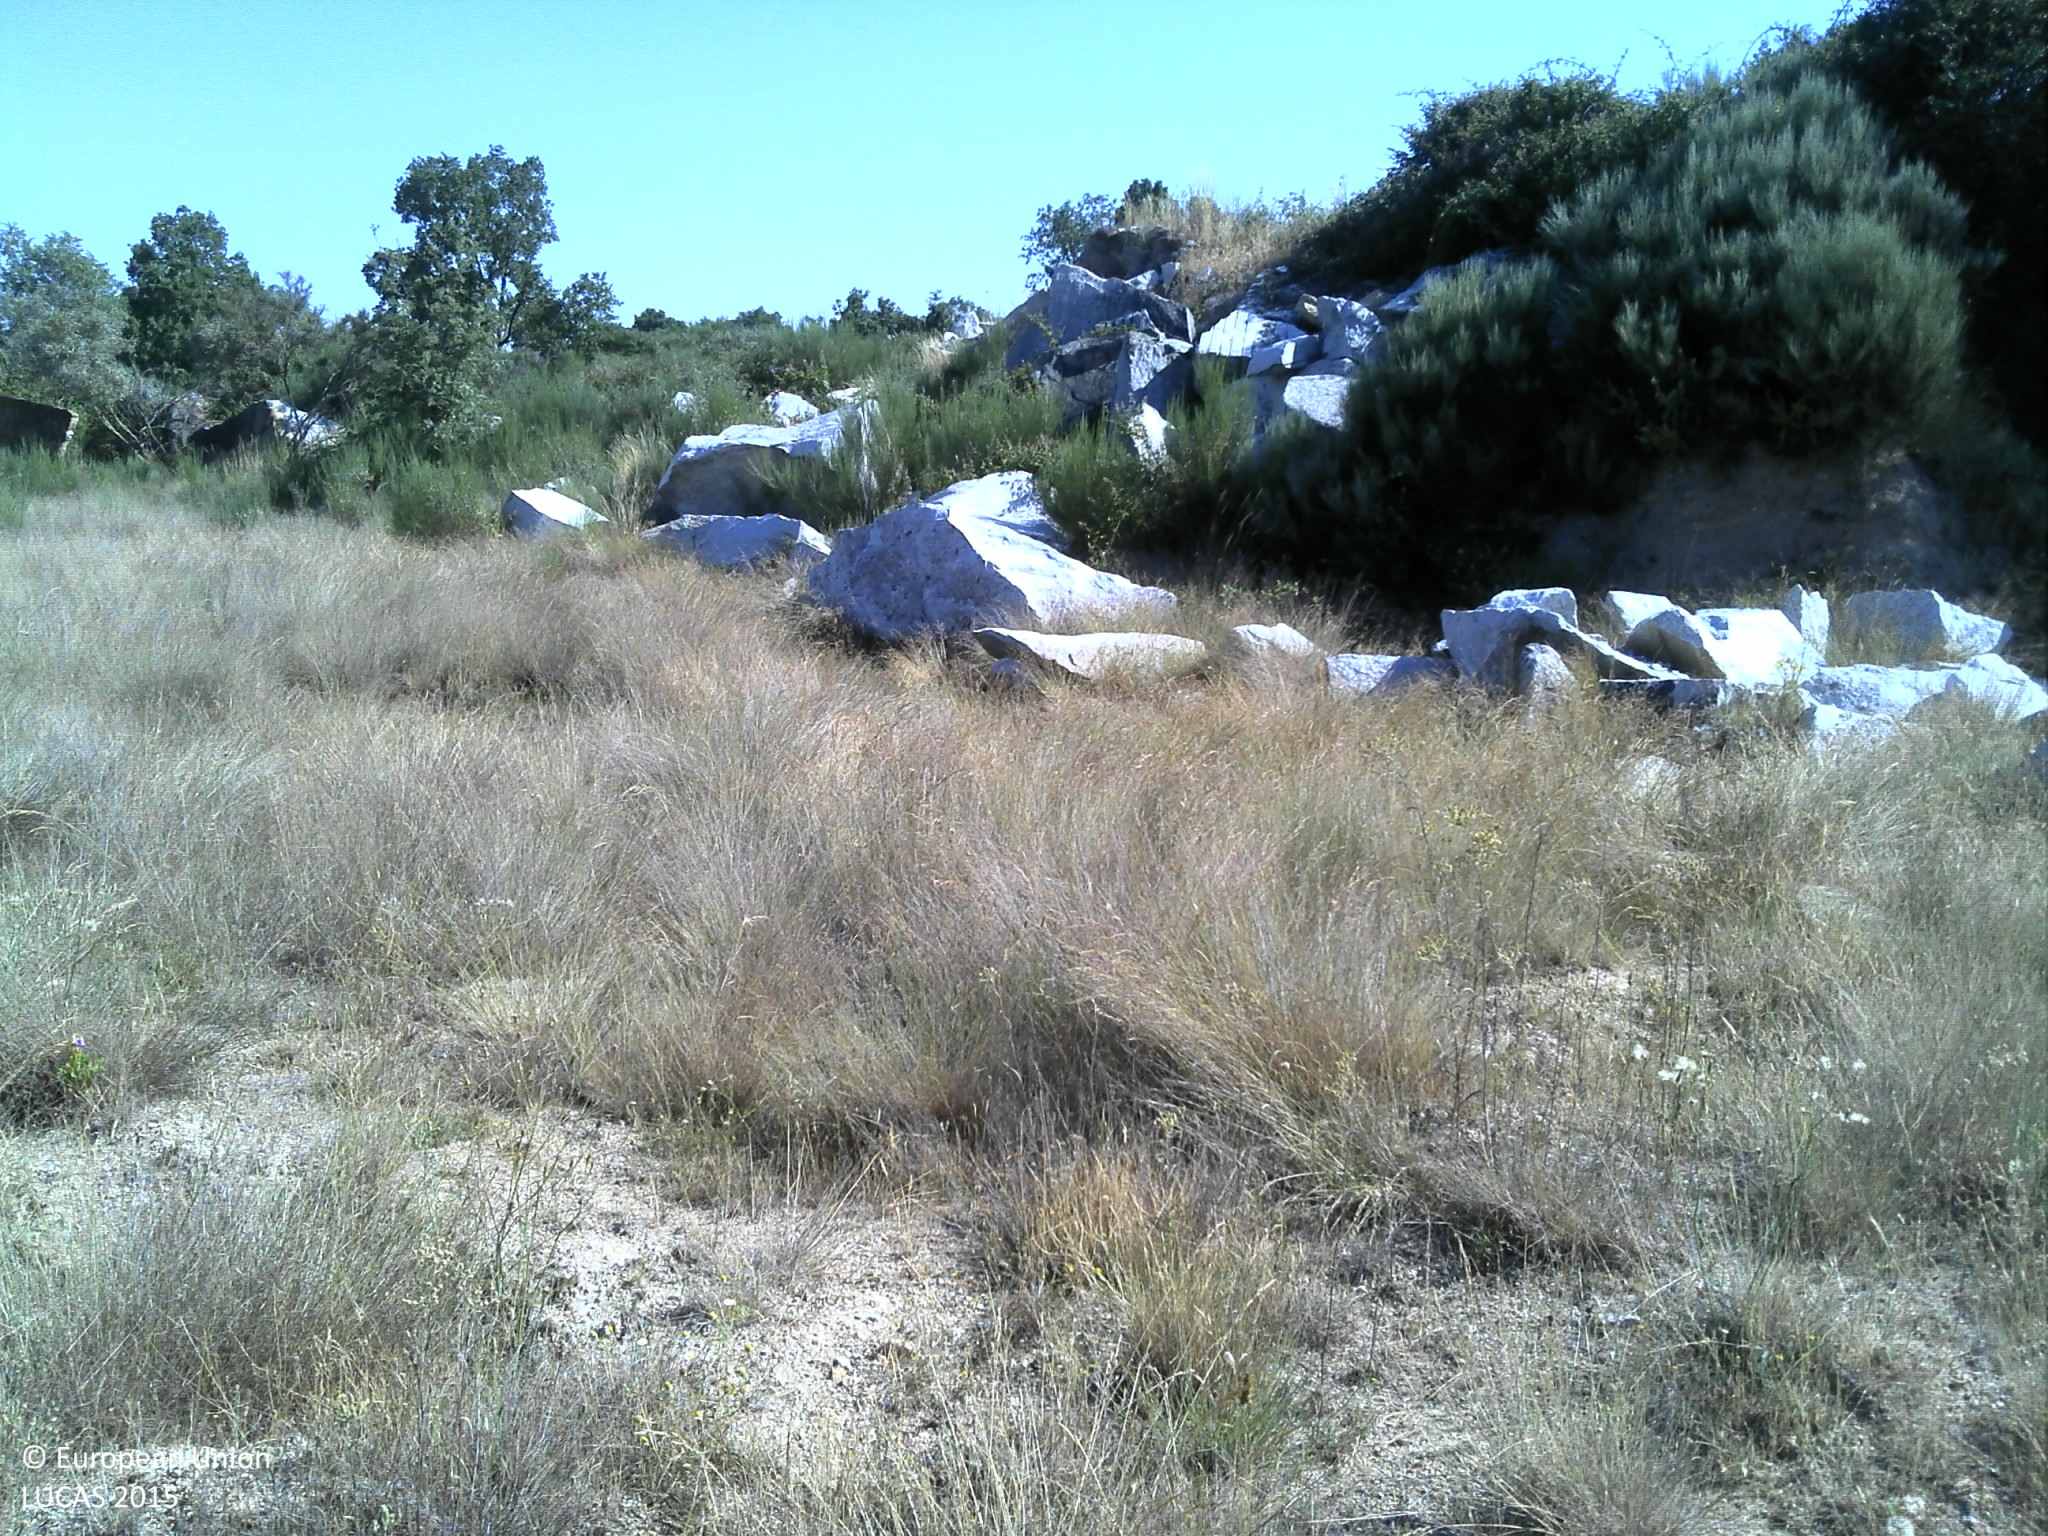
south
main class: Shrubland
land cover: Shrubland without tree cover
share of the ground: 25 - 50 %
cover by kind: unconsolidated bare surface 40 %, herbaceous plants 30 %, shrubs 25 %, consolidated bare surface 5 %
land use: Abandoned areas
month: June
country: PT
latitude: 40.7677
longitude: -6.8634
